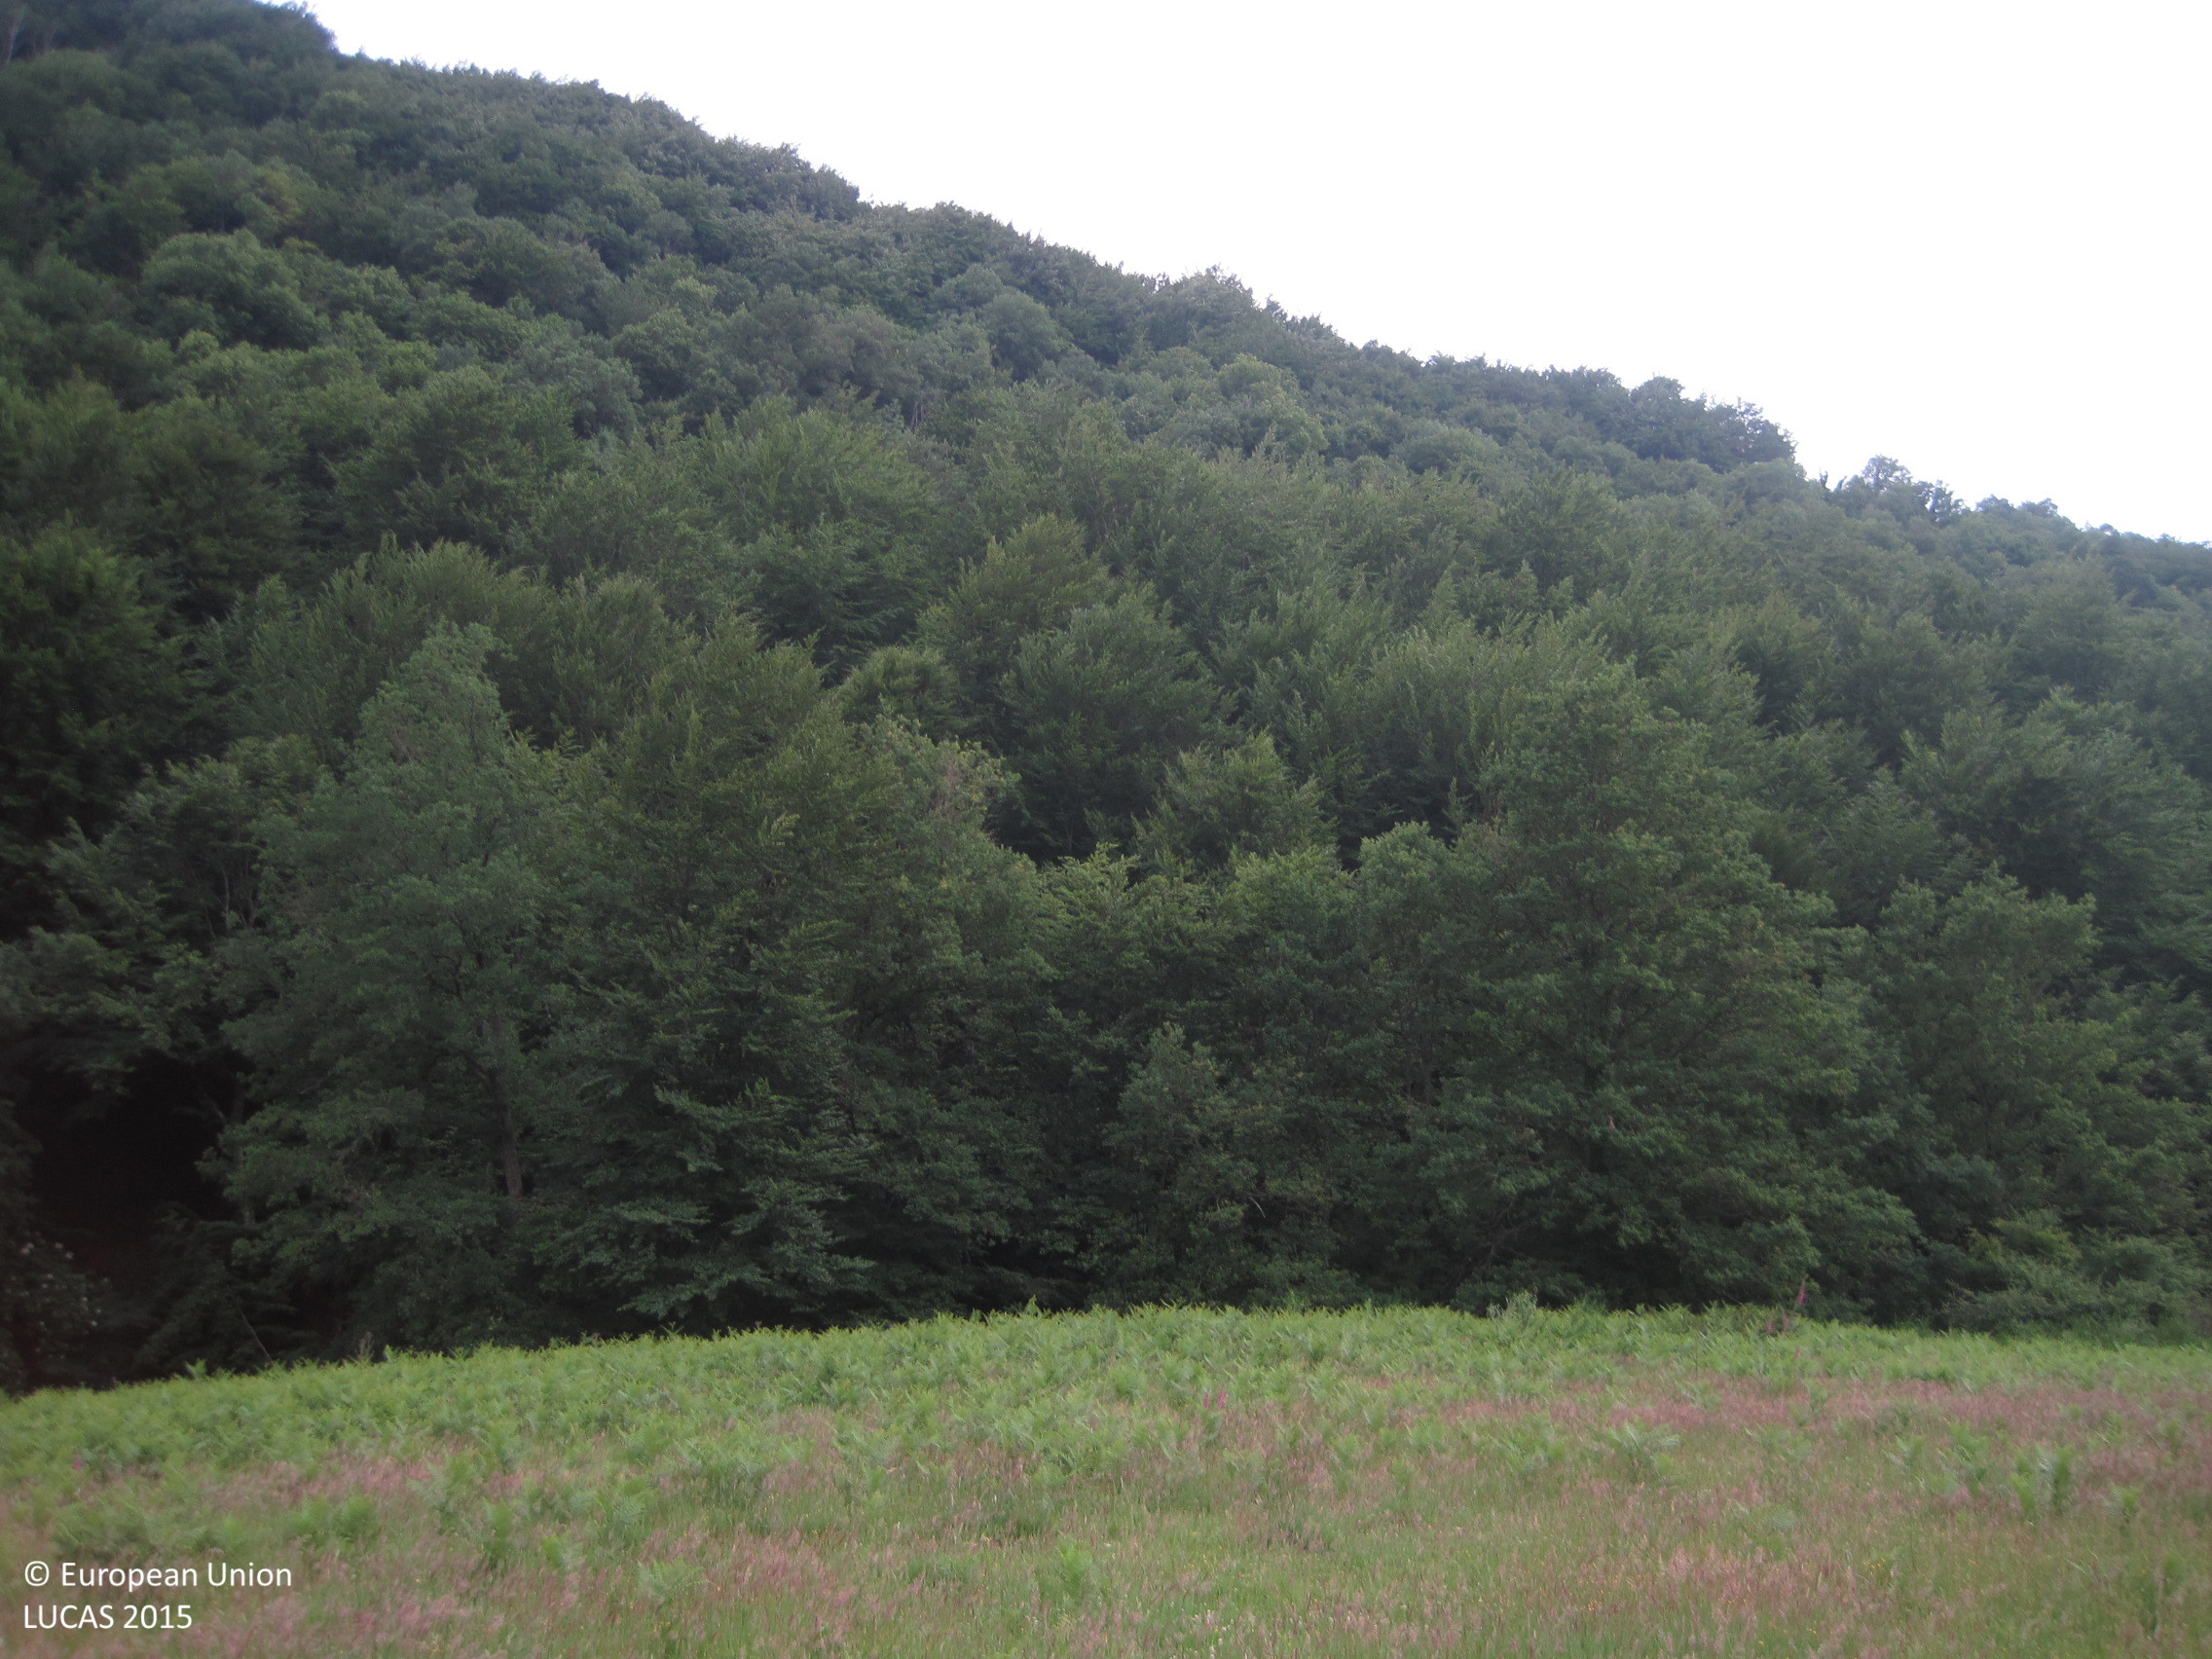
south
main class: Grassland
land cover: Grassland without tree/shrub cover
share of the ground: > 75 %
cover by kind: herbaceous plants 100 %
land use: Agriculture (excluding fallow land and kitchen gardens)
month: June
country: ES
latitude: 43.0206
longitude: -1.7856
